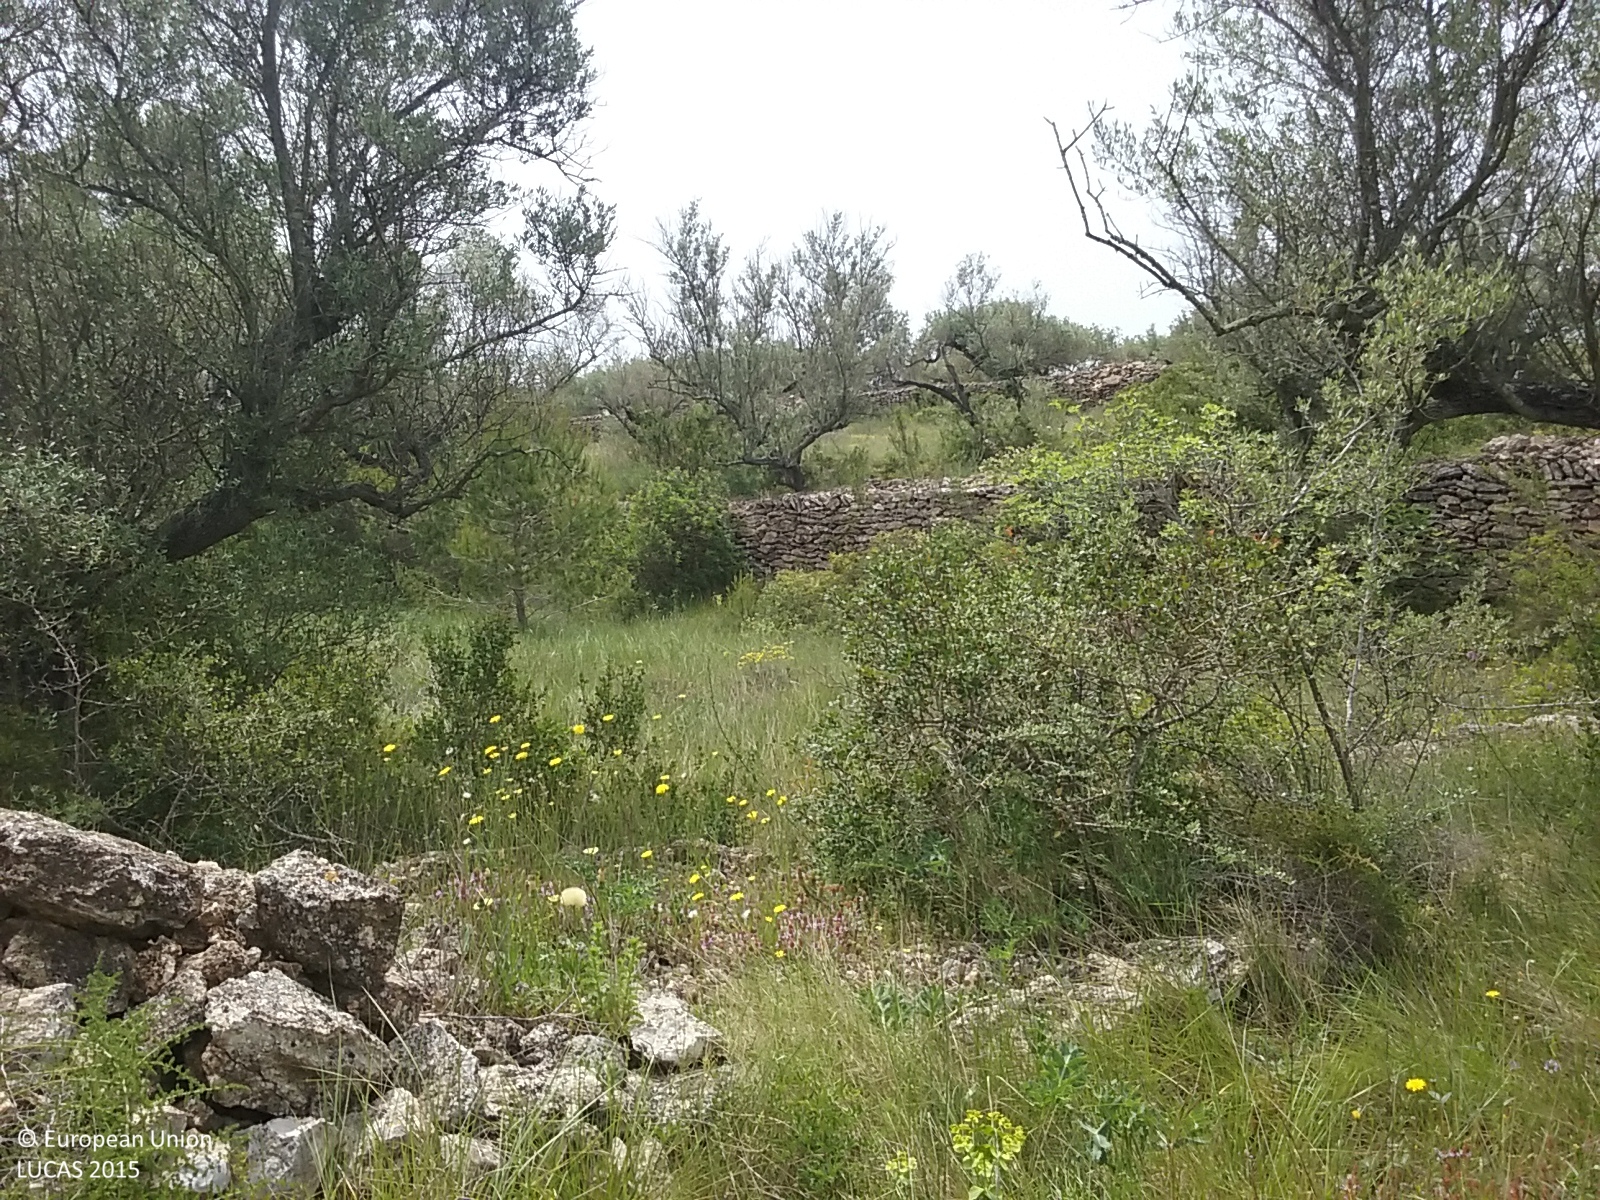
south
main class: Cropland
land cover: Olive groves
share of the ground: 25 - 50 %
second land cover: Grassland without tree/shrub cover
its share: > 75 %
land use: Abandoned areas
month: May
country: ES
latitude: 40.7974
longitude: 0.5954
